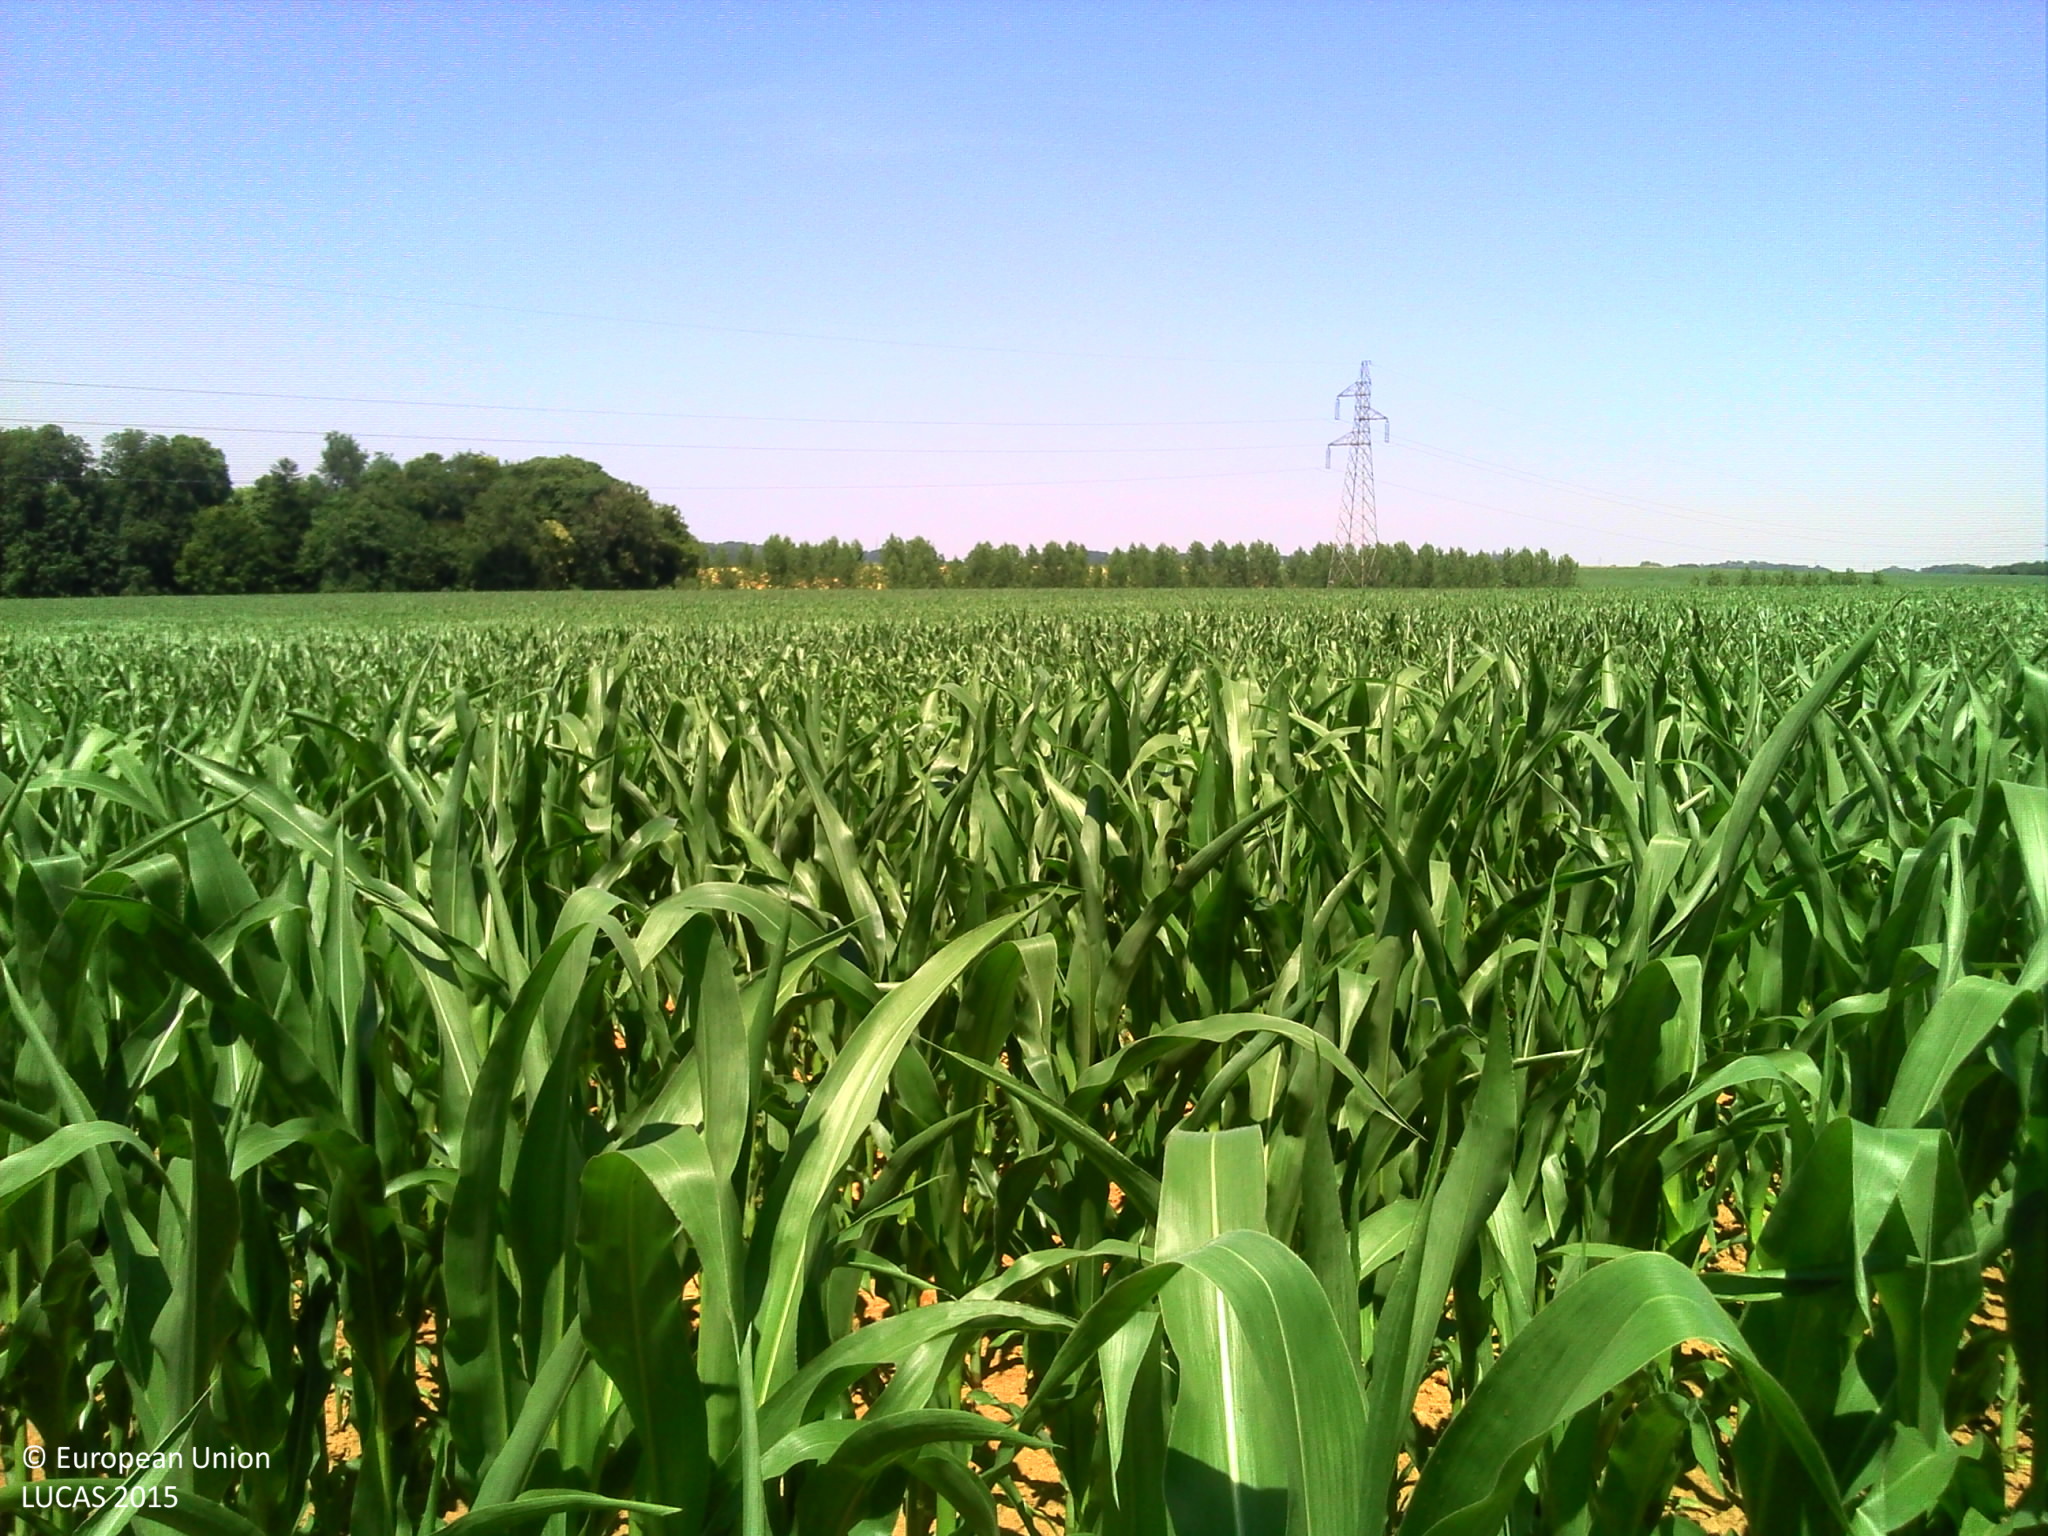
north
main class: Cropland
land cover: Maize
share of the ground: 50 - 75 %
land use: Agriculture (excluding fallow land and kitchen gardens)
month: July
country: FR
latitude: 48.8910
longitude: 5.1291
